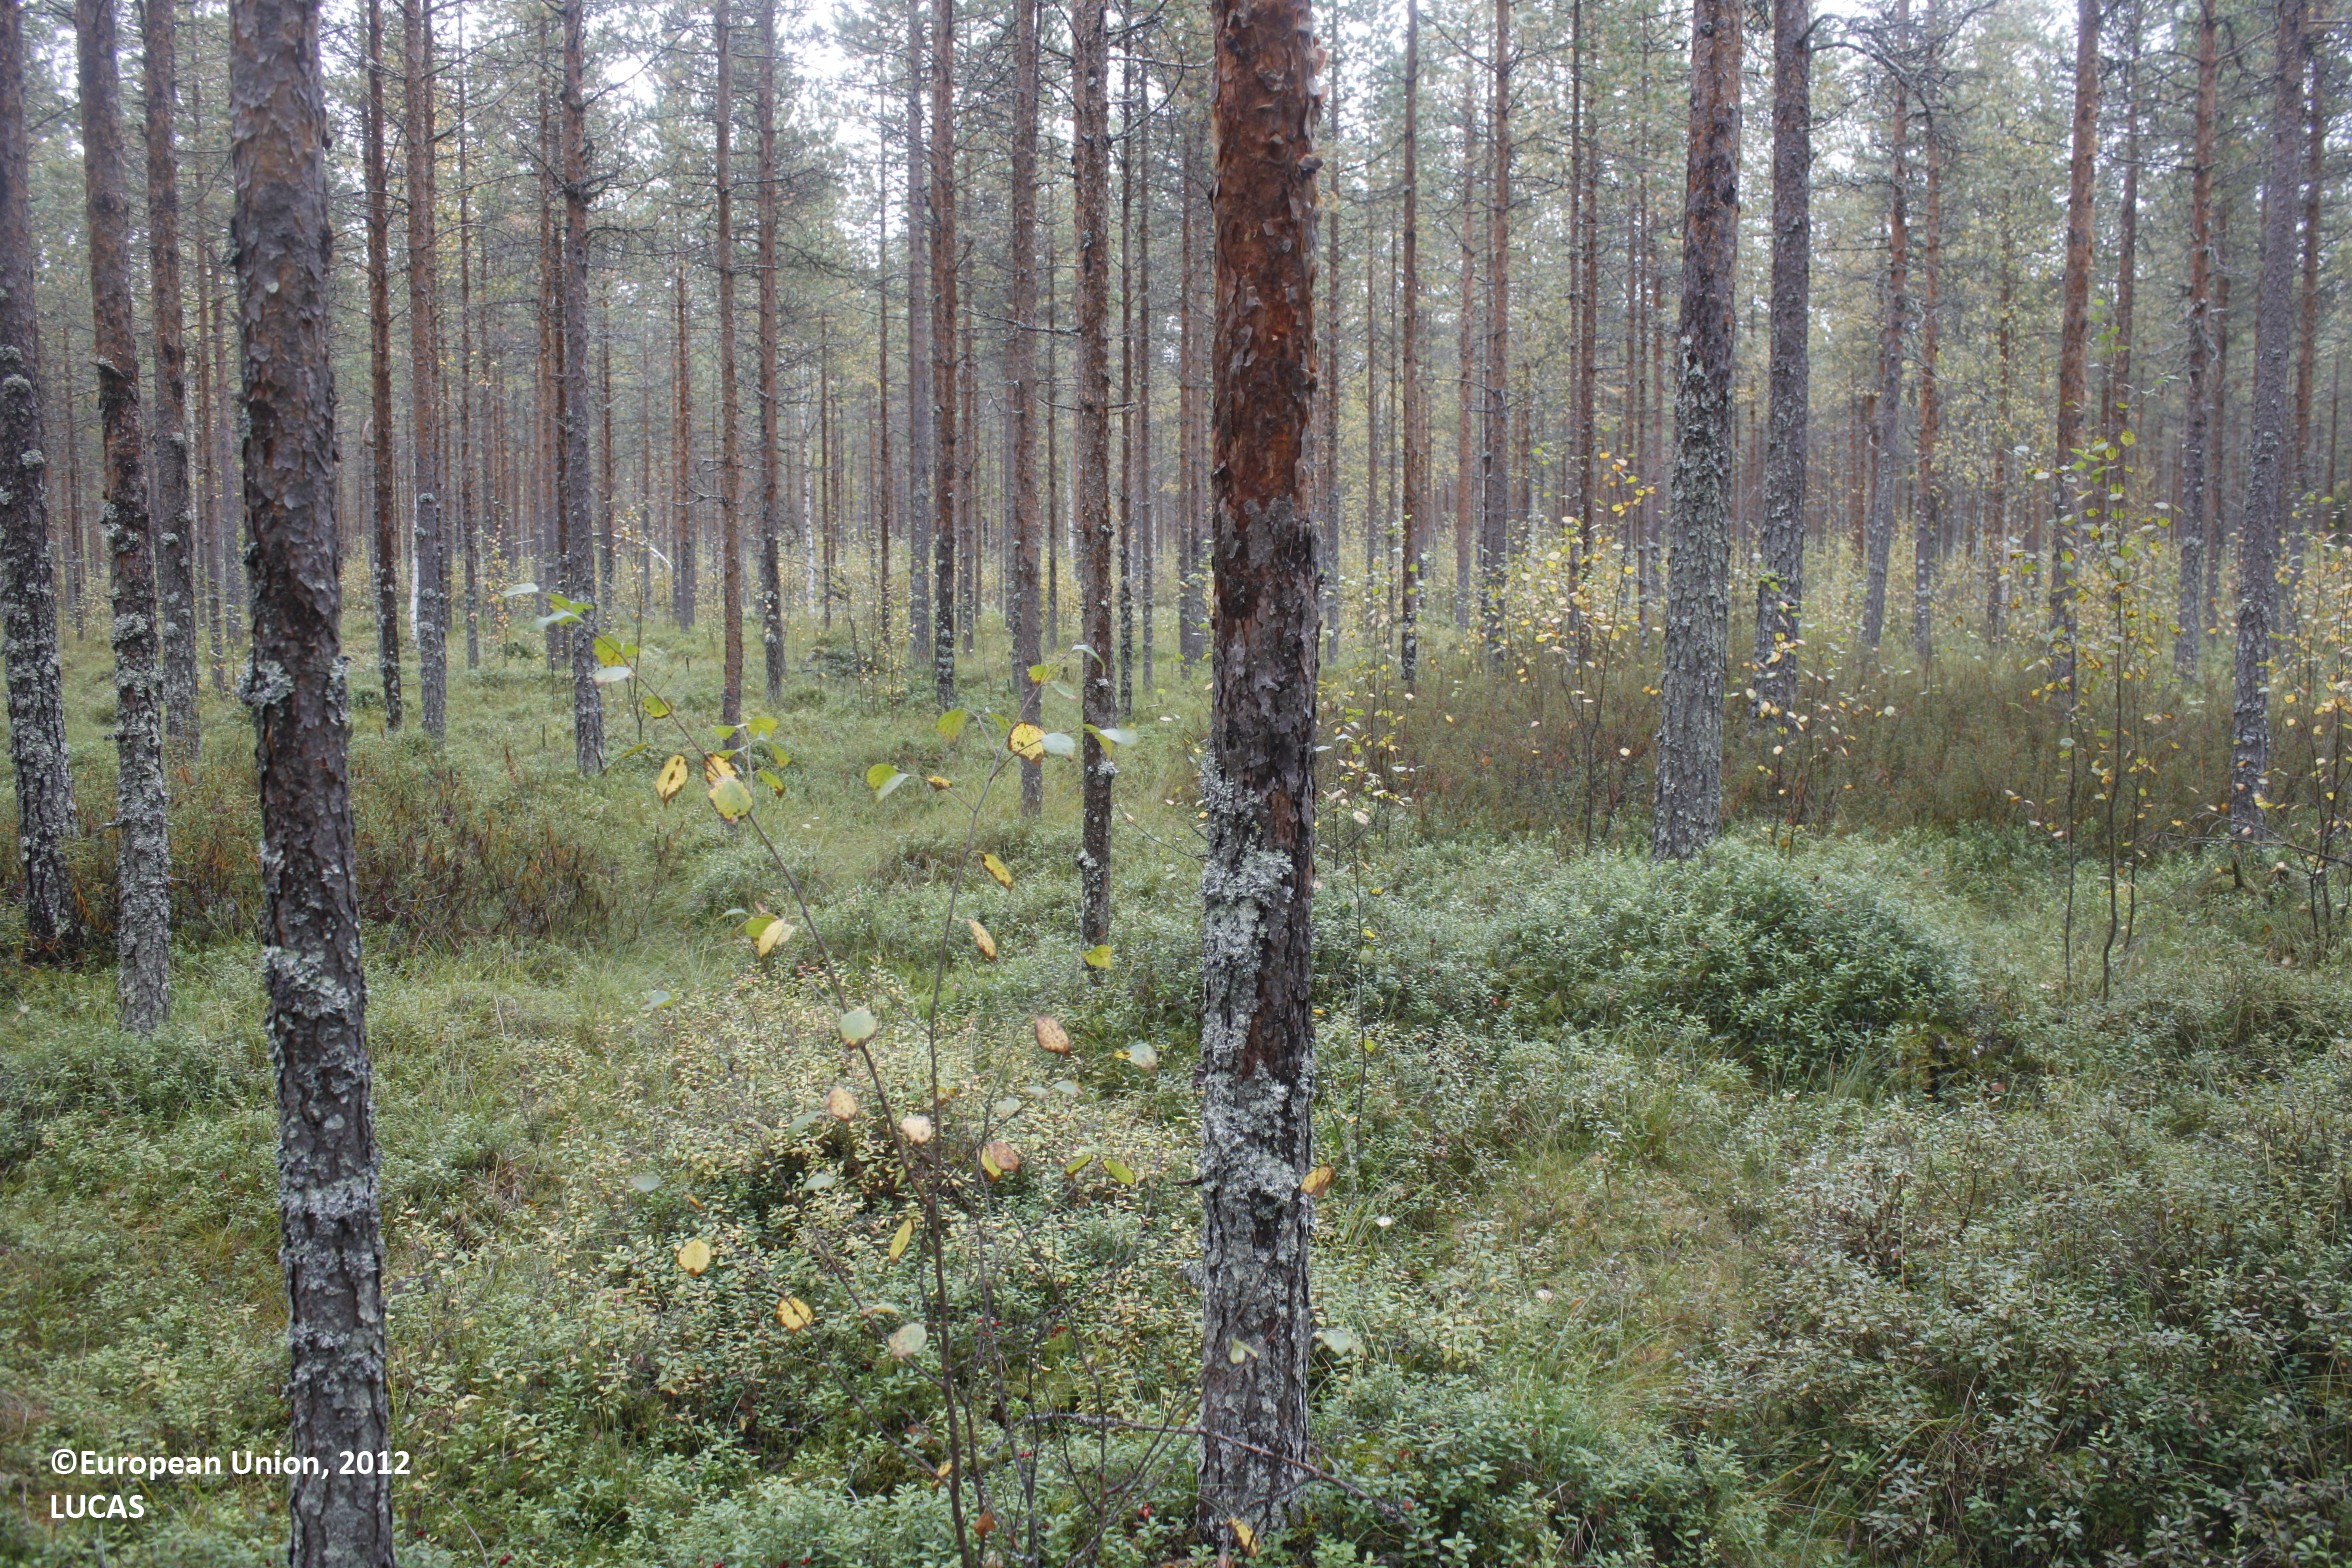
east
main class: Woodland
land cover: Pine dominated coniferous woodland
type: boreal forest
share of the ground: 50 - 75 %
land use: Forestry
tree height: > 5 m
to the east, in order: Pine dominated coniferous woodland; Pine dominated mixed woodland; Ditches and canals; Pine dominated coniferous woodland; Pine dominated mixed woodland; Inland running water; Other mixed woodland
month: September
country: FI
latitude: 65.1050
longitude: 26.6532
